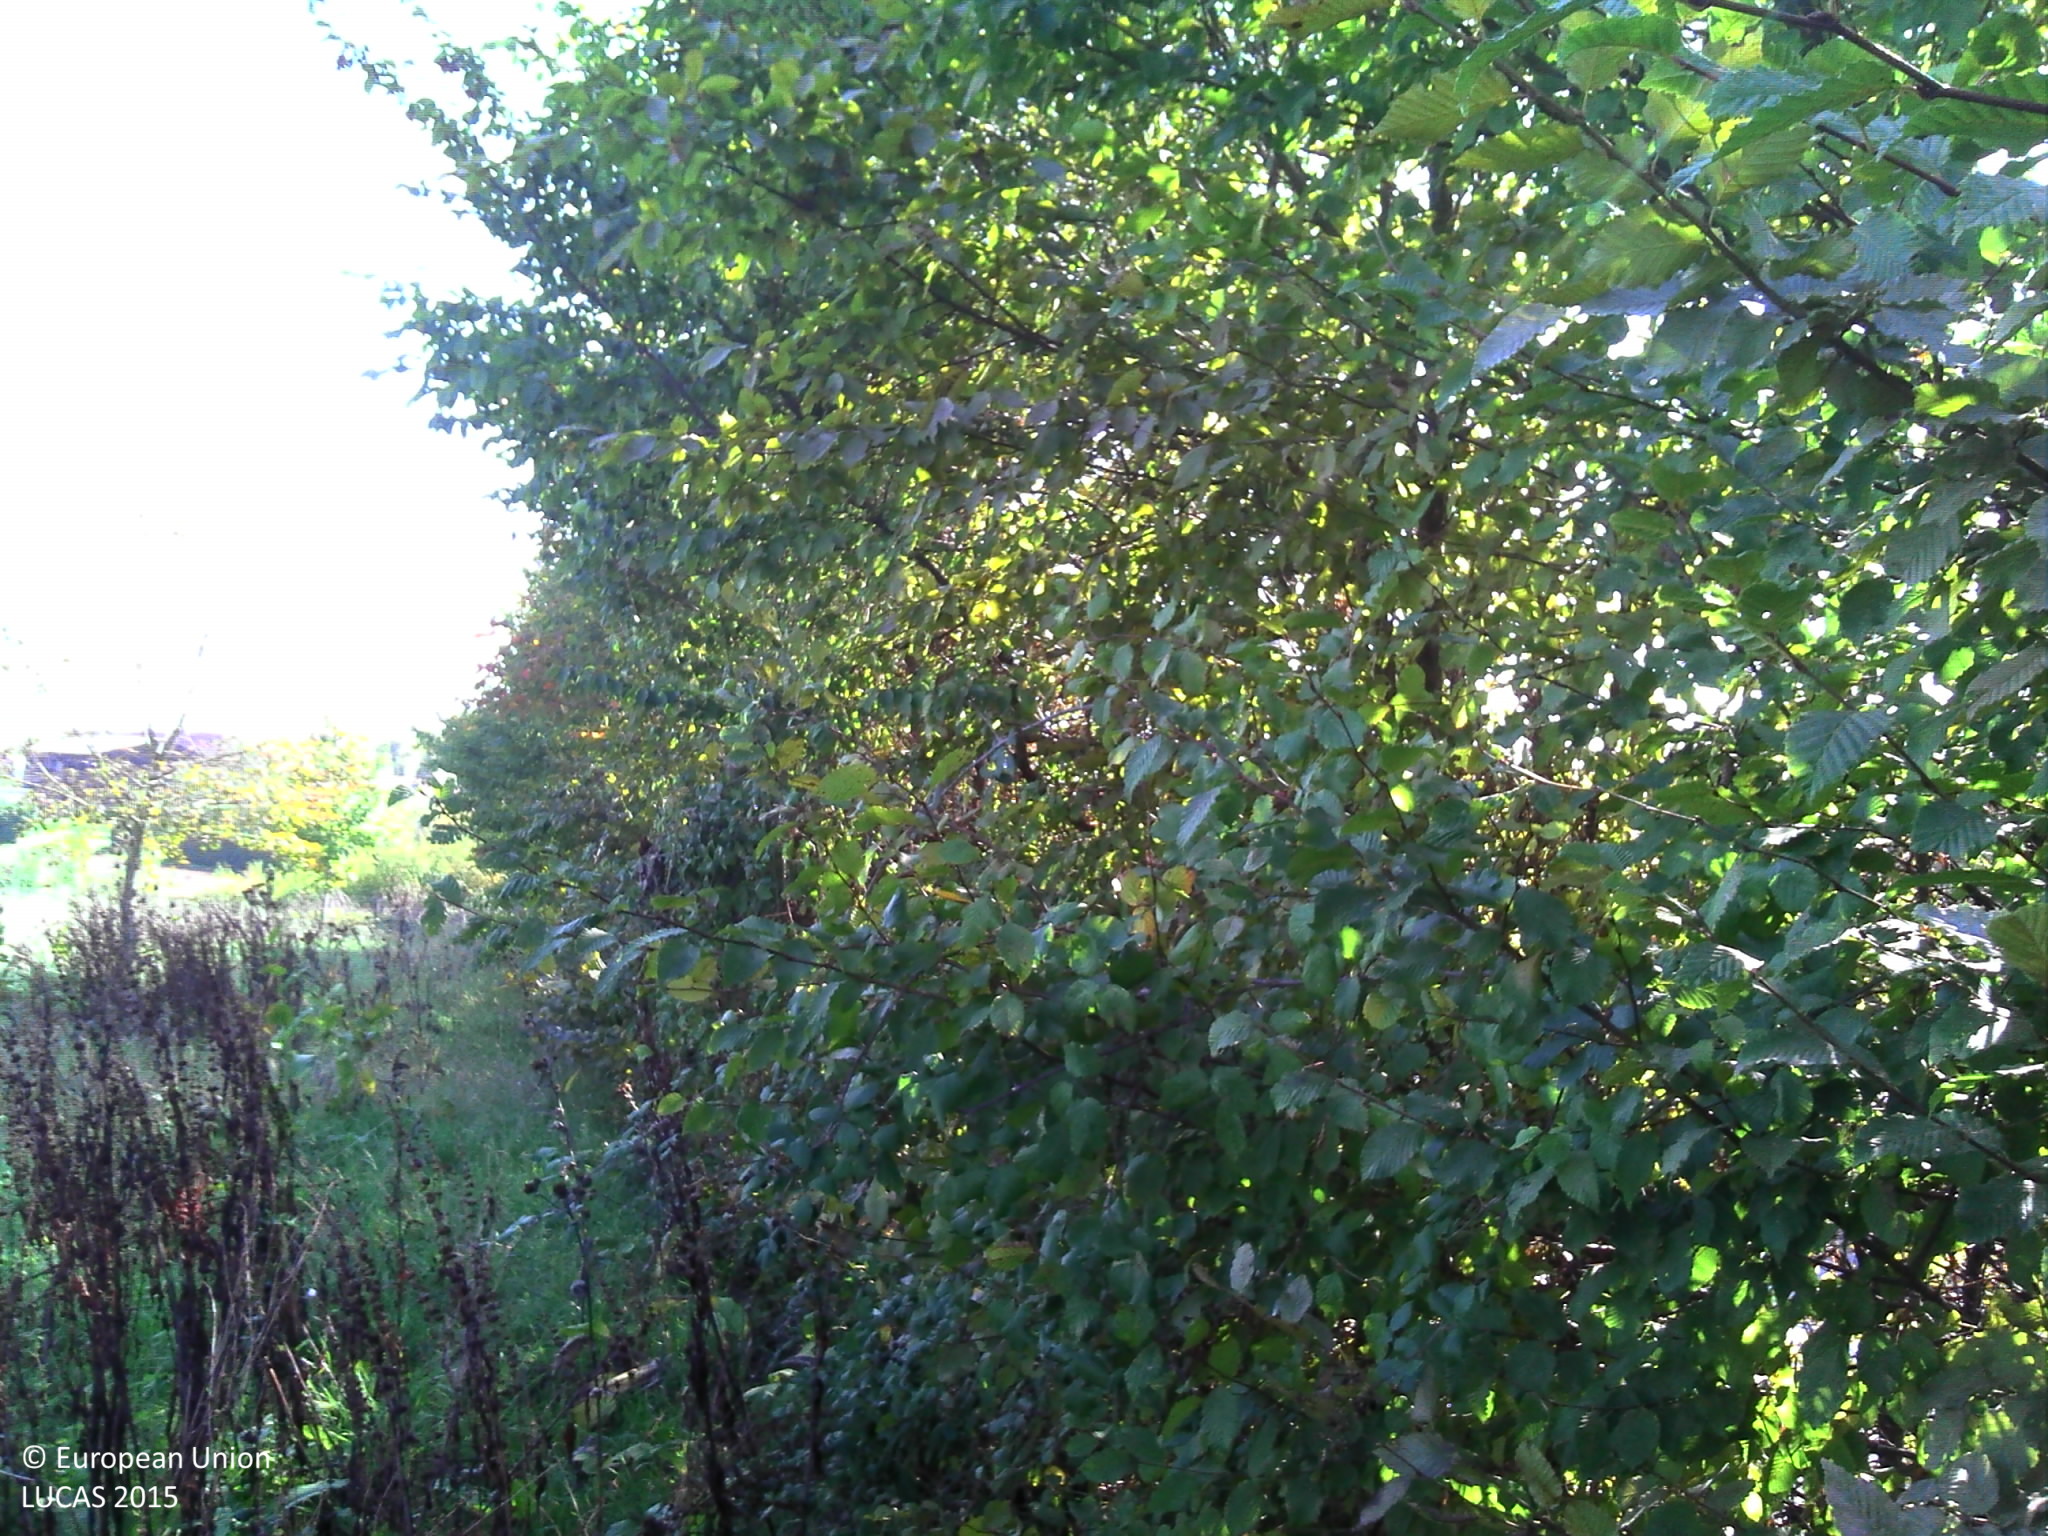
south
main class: Grassland
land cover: Spontaneously vegetated surfaces
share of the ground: > 75 %
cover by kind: herbaceous plants 100 %
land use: Abandoned areas
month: October
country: FR
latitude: 46.2287
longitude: 4.8810
